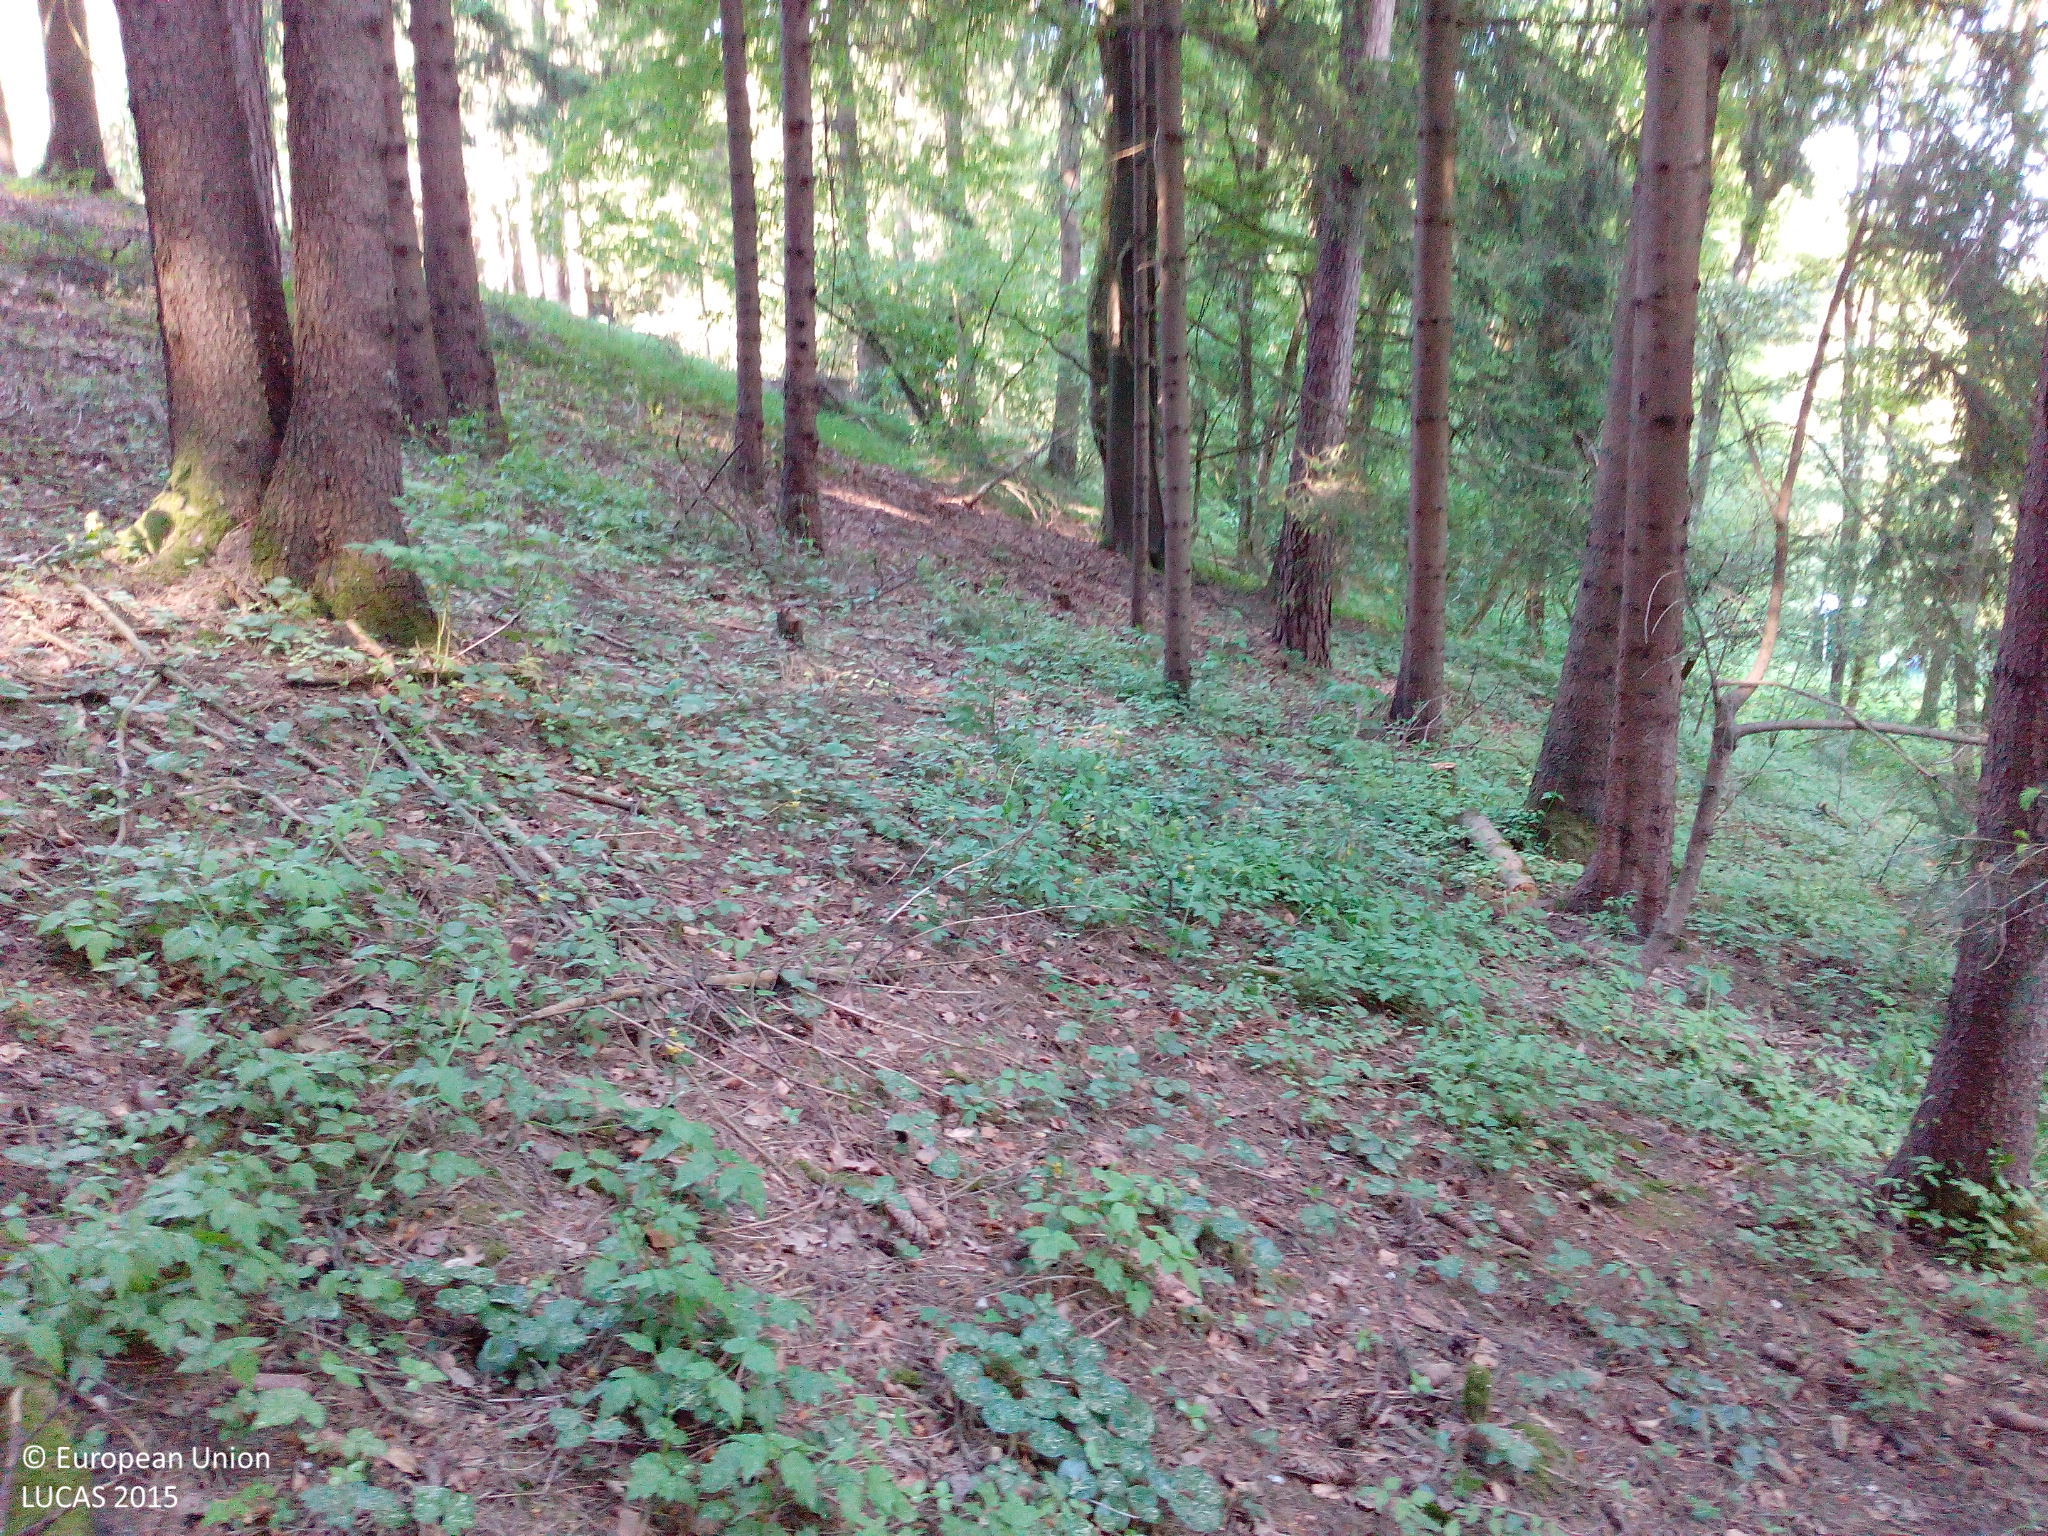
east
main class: Woodland
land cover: Other coniferous woodland
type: hemiboreal forest and nemoral coniferous forest and mixed broadleaved-coniferous forest
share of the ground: > 75 %
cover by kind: coniferous forest trees 85 %, unconsolidated bare surface 10 %, herbaceous plants 5 %
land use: Forestry
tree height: > 5 m
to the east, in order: Other coniferous woodland; Broadleaved woodland; Tracks; Other mixed woodland; Fences; Broadleaved woodland; Fences; Broadleaved woodland; Tracks; Broadleaved woodland; Tracks; Broadleaved woodland
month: May
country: DE
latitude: 49.1851
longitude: 11.4949
